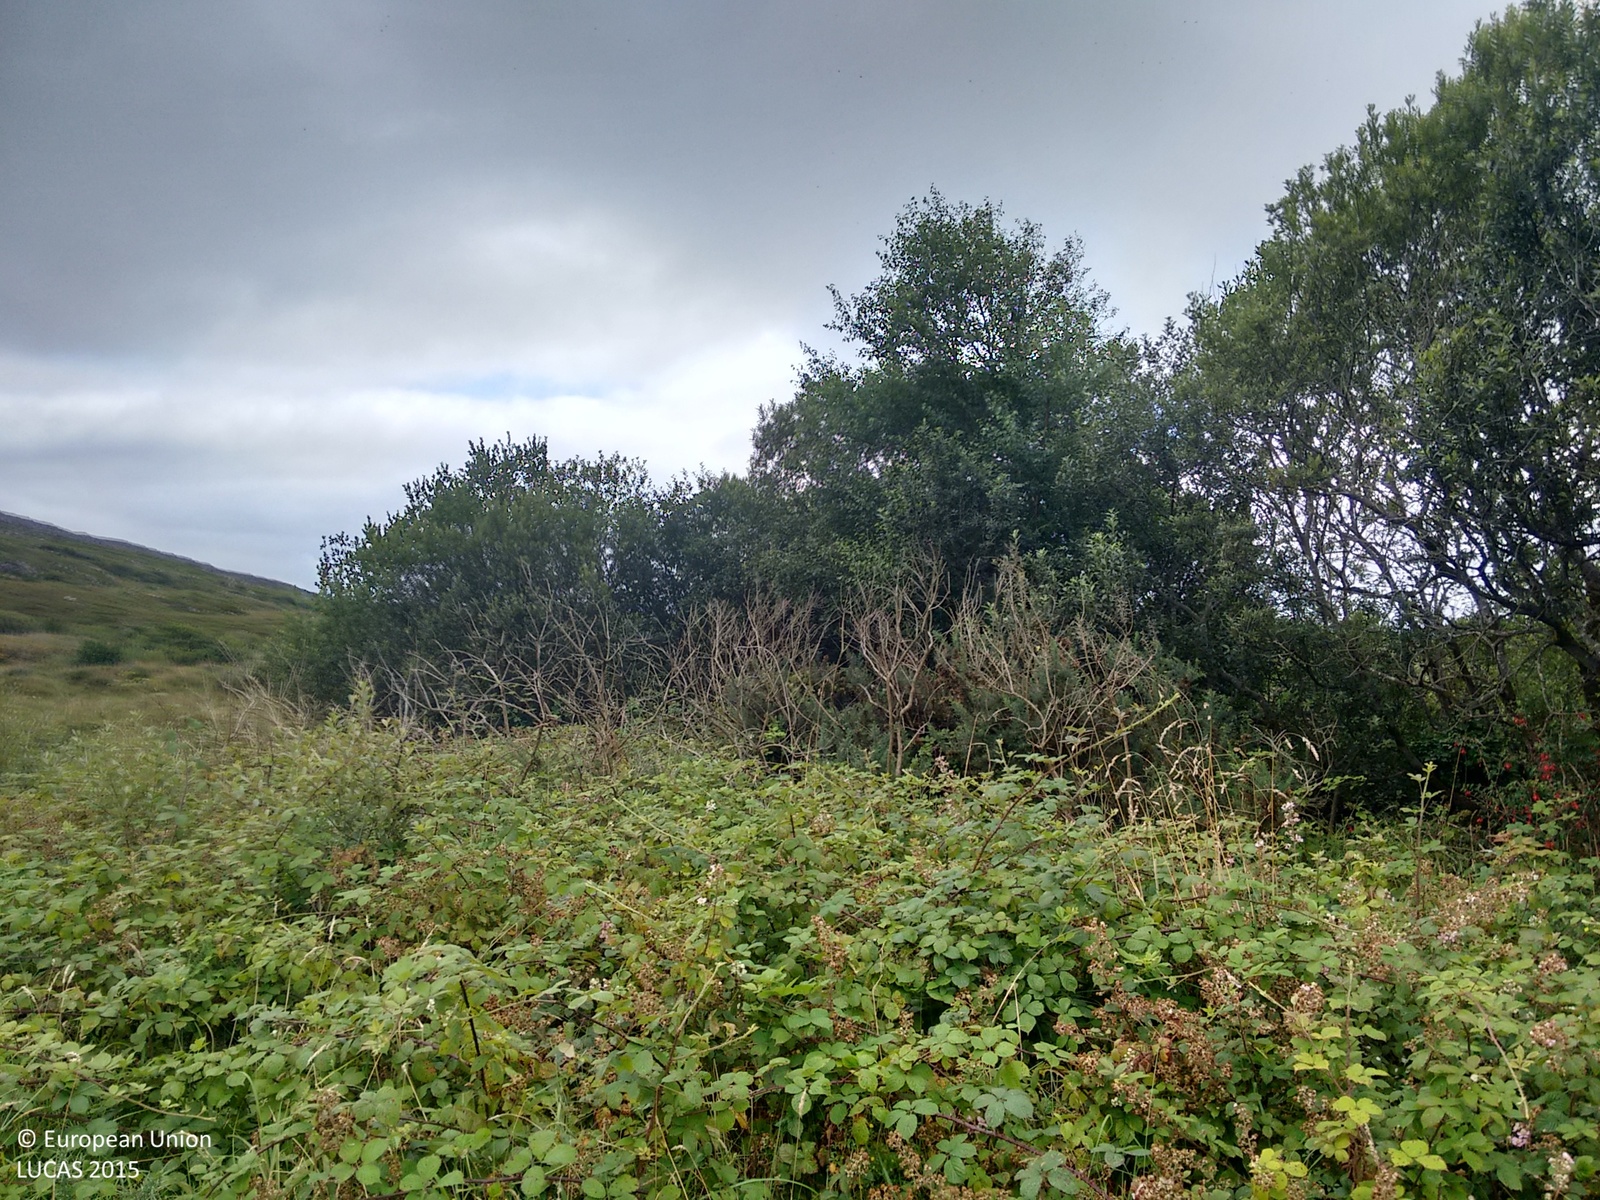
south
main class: Grassland
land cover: Grassland with sparse tree/shrub cover
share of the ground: > 75 %
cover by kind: herbaceous plants 85 %, shrubs 10 %, broadleaved forest trees 5 %
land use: Agriculture (excluding fallow land and kitchen gardens)
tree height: < 5 m
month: August
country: IE
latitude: 51.7963
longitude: -10.0181
